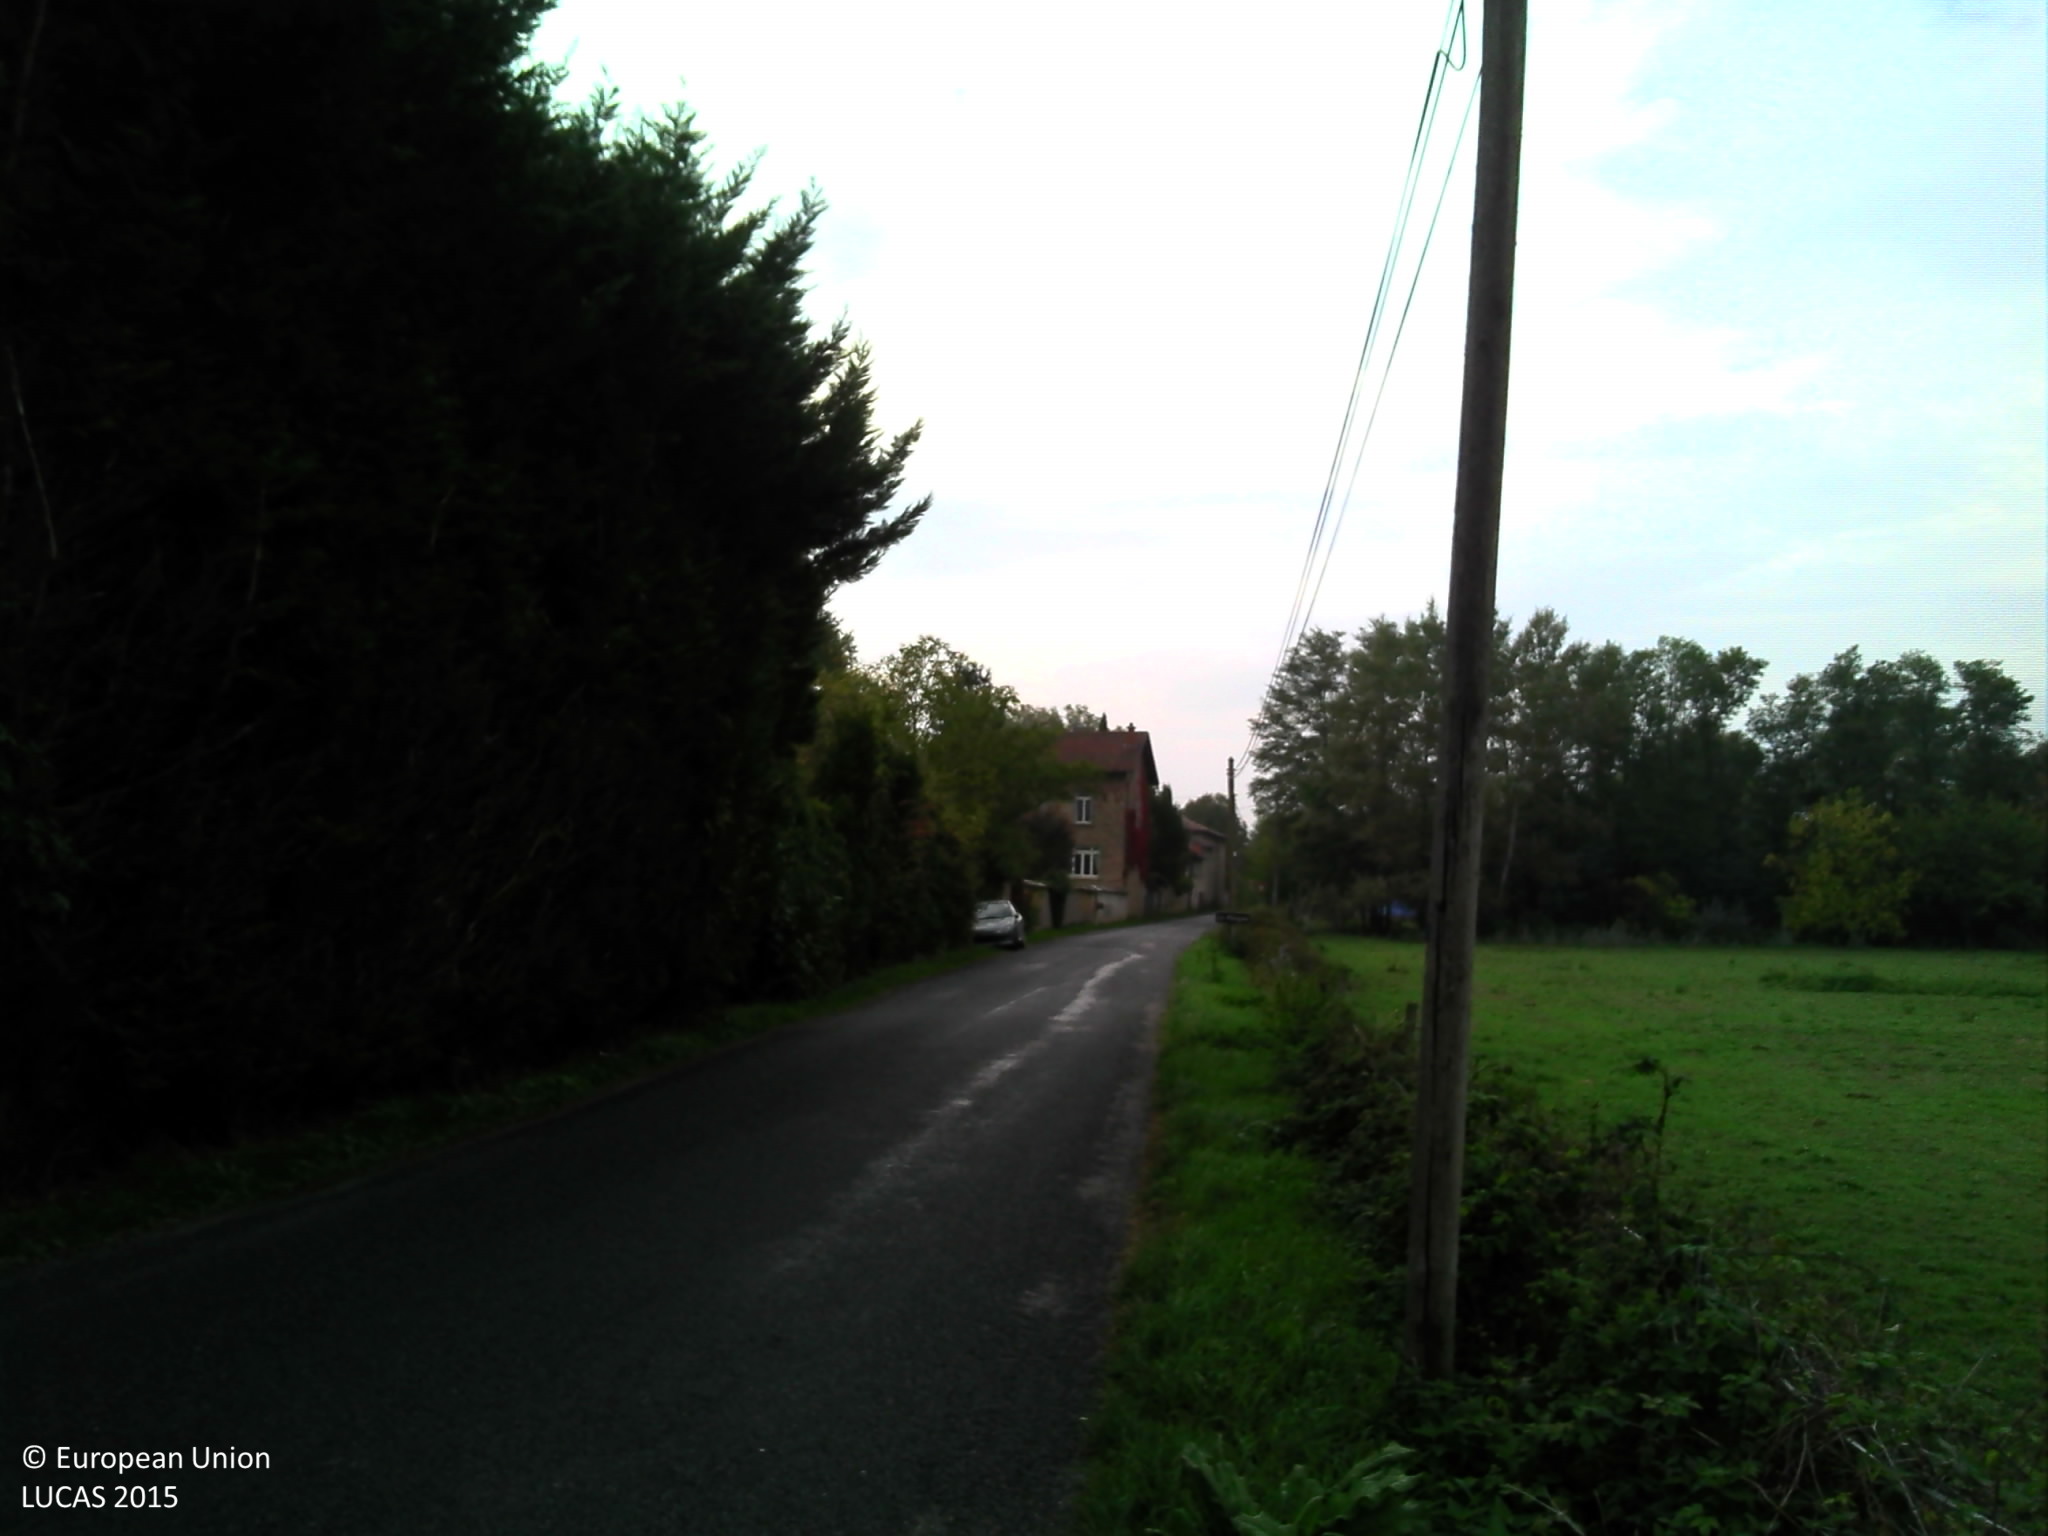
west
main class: Grassland
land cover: Grassland without tree/shrub cover
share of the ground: > 75 %
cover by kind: herbaceous plants 100 %
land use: Agriculture (excluding fallow land and kitchen gardens)
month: October
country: FR
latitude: 46.1710
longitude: 4.8087
